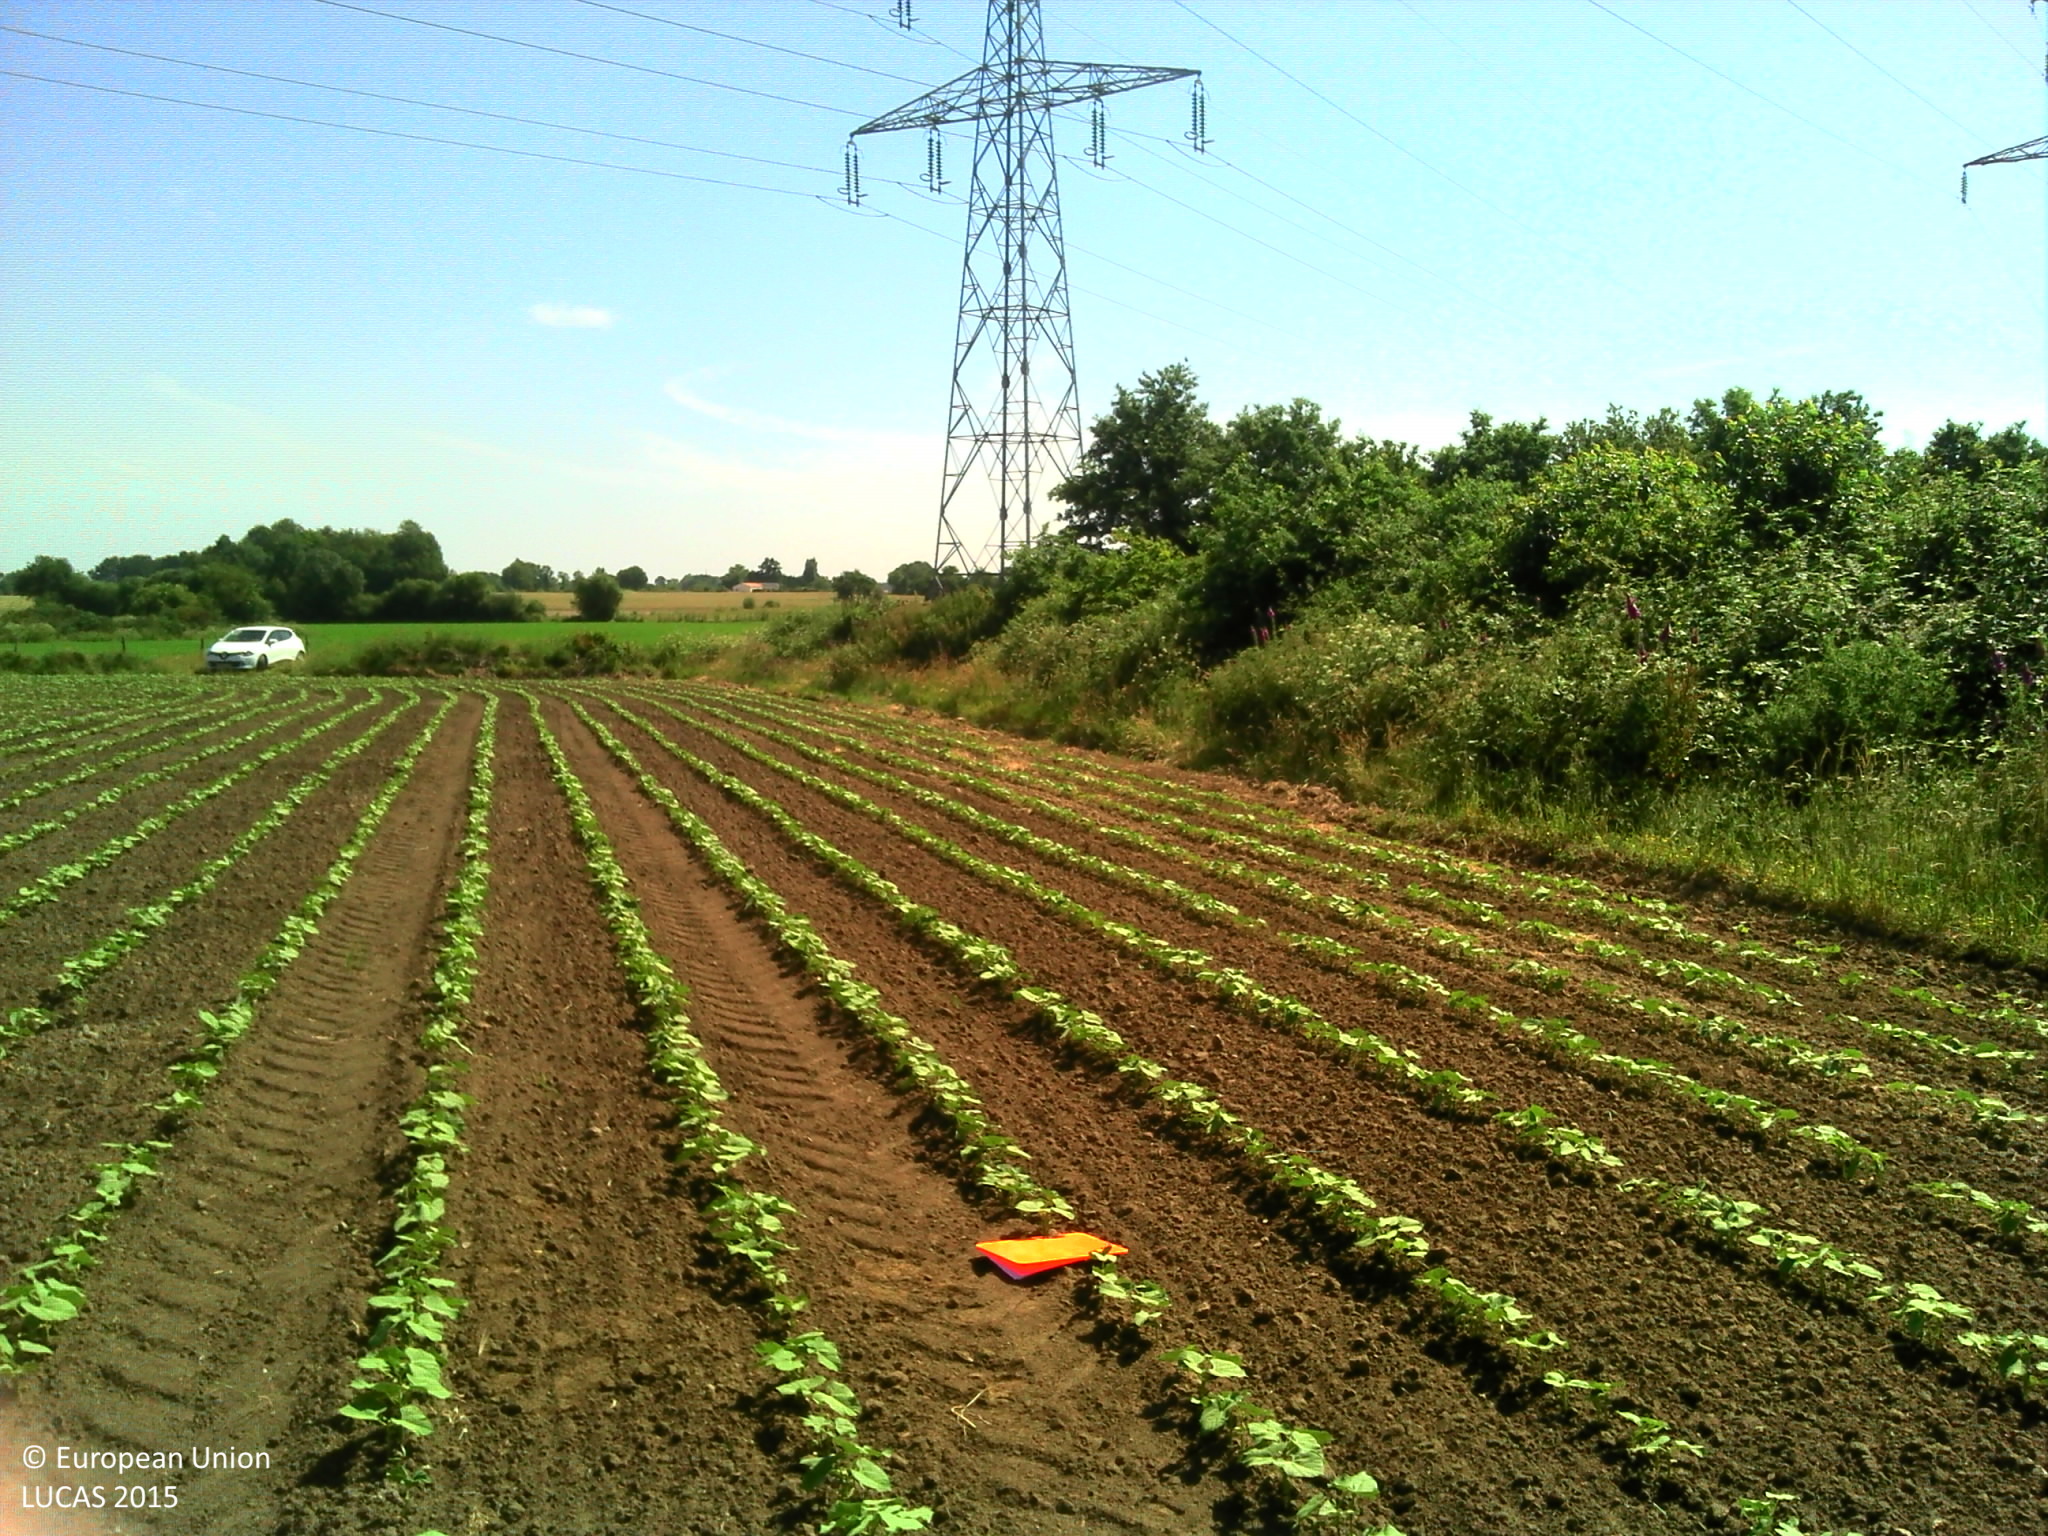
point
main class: Cropland
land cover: Dry pulses
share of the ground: 10 - 25 %
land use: Agriculture (excluding fallow land and kitchen gardens)
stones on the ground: < 10 %
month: June
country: FR
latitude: 46.7916
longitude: -1.4226
